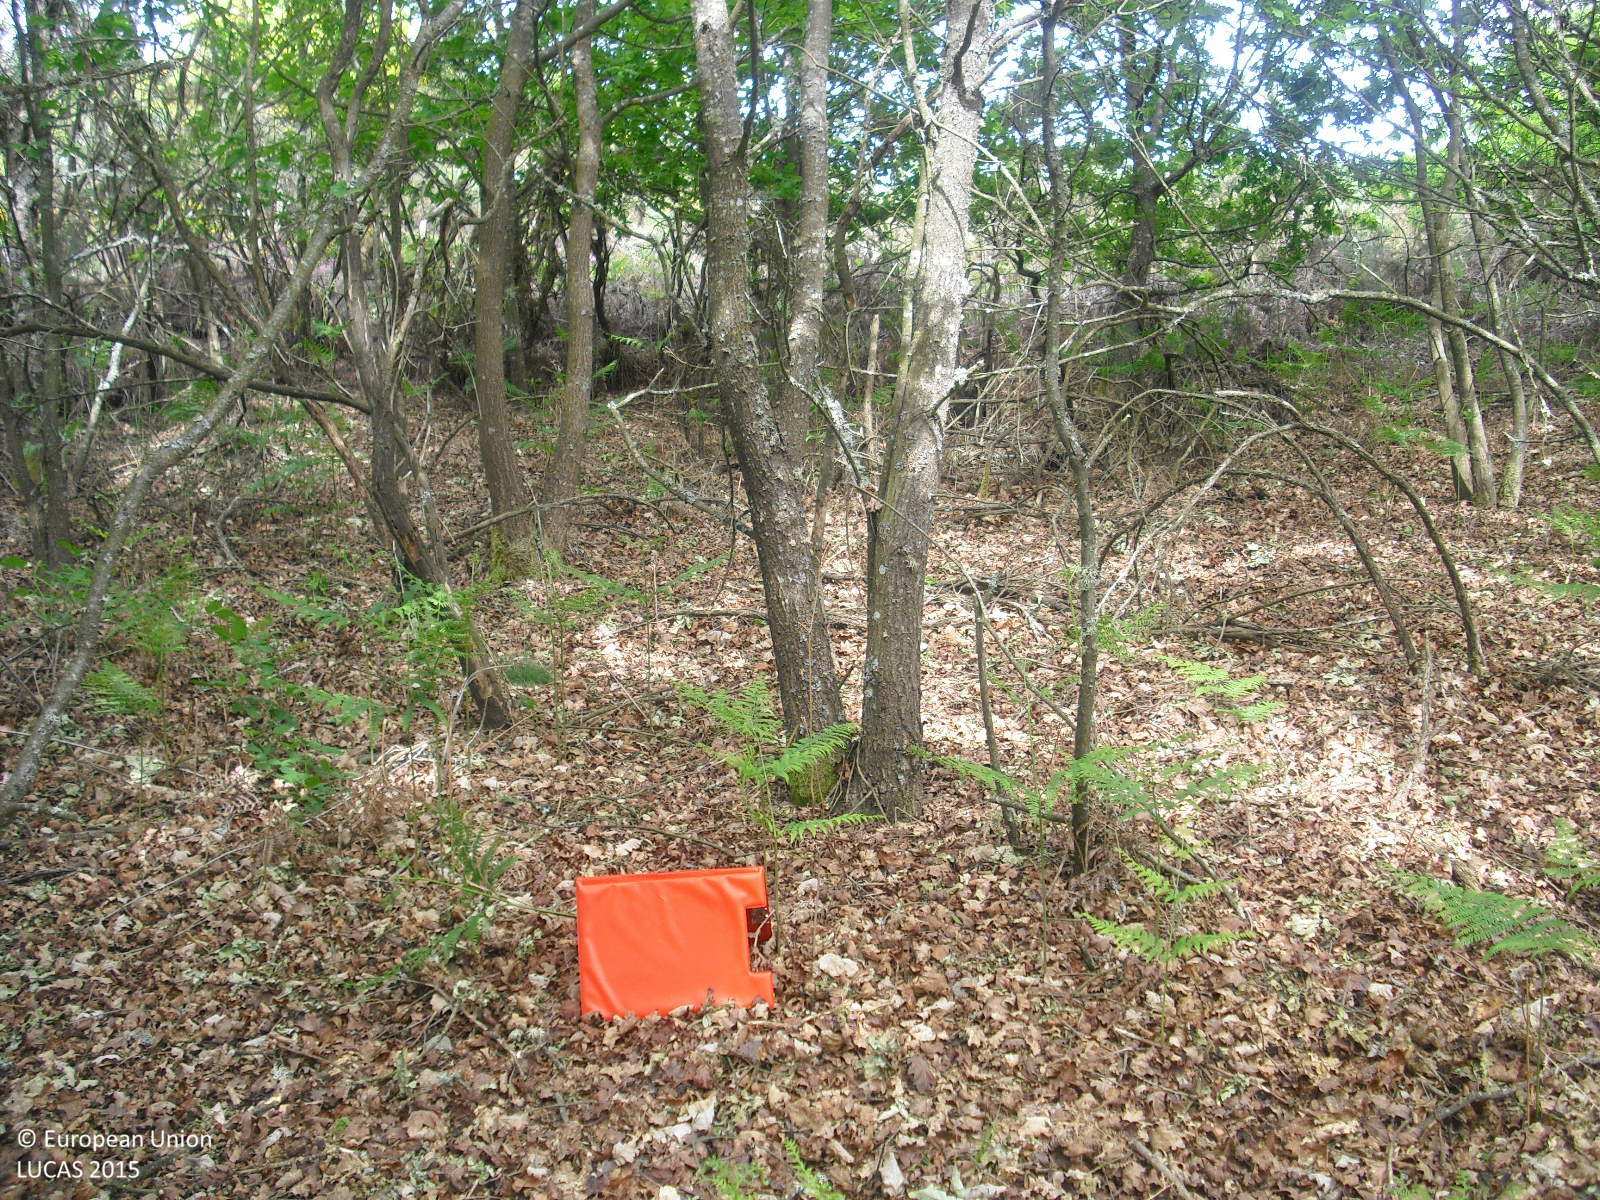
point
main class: Woodland
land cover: Broadleaved woodland
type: acidophilous oak and oak-birch forest
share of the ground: 50 - 75 %
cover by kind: broadleaved forest trees 60 %, shrubs 40 %
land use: Semi-natural and natural areas not in use
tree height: > 5 m
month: May
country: ES
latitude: 42.1548
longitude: -7.7776
